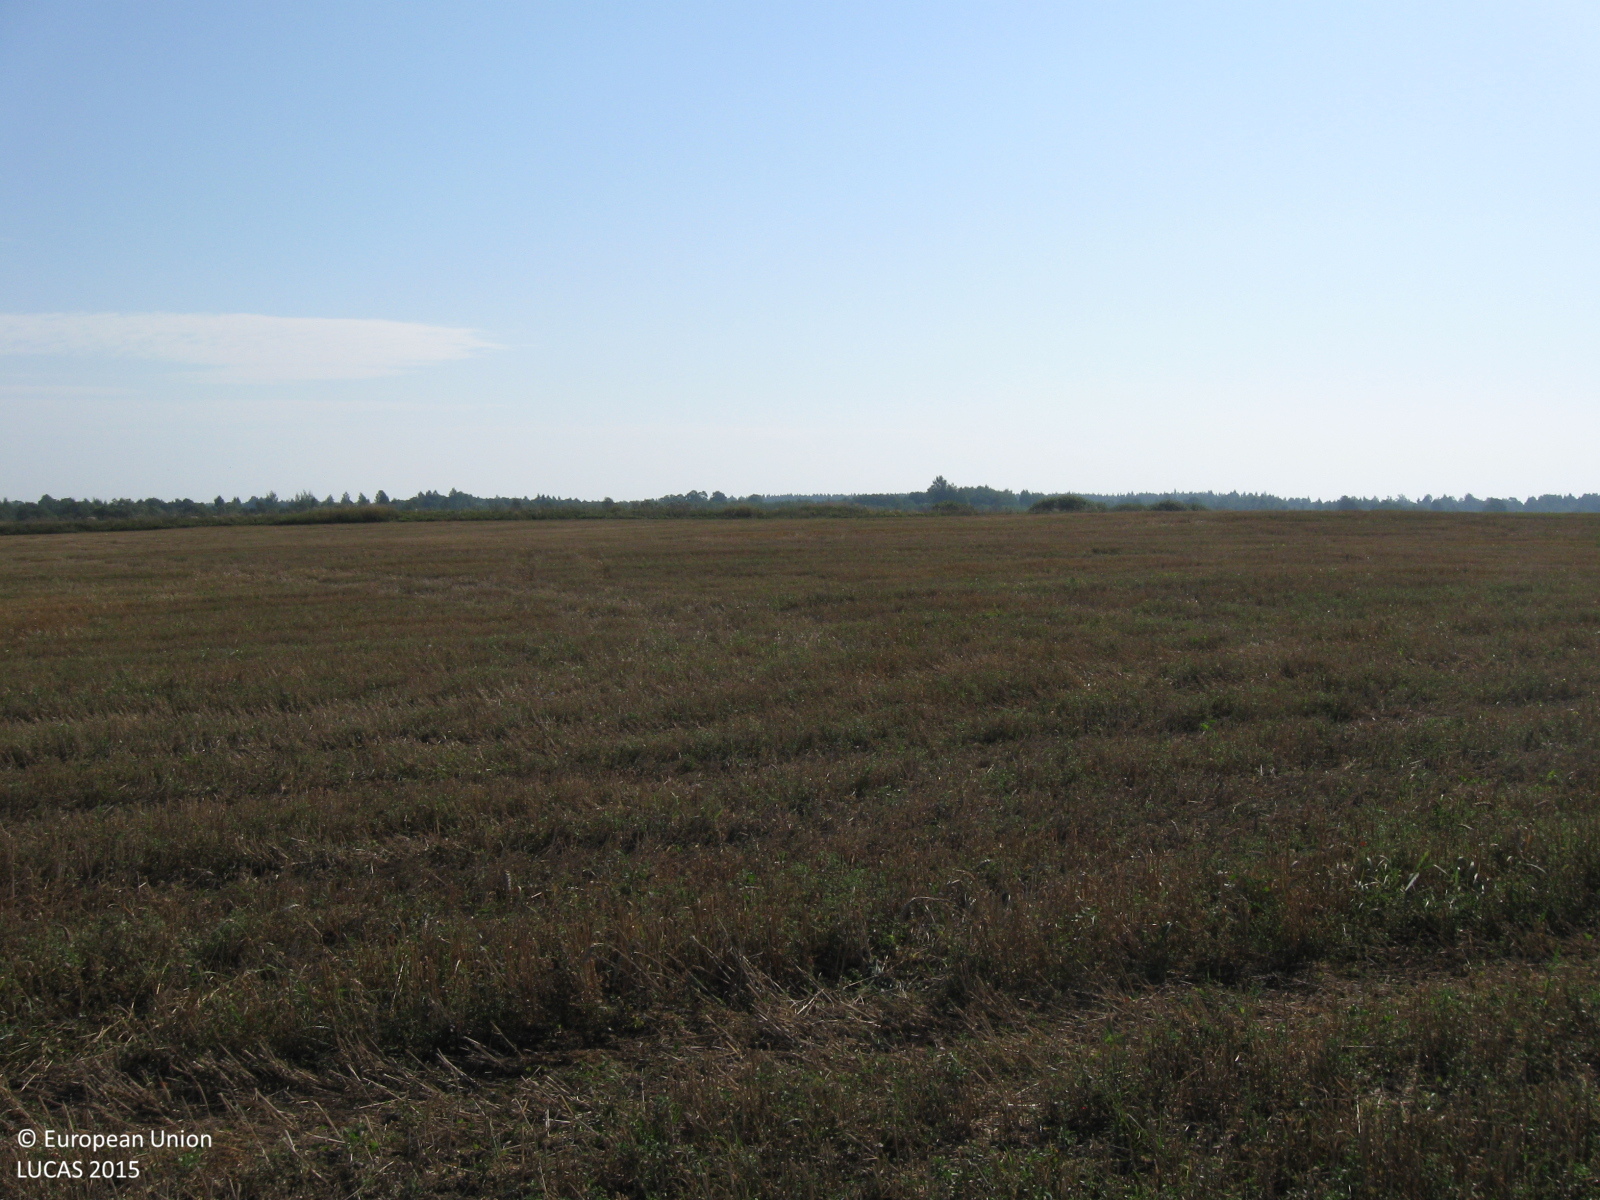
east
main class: Cropland
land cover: Common wheat
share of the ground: > 75 %
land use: Agriculture (excluding fallow land and kitchen gardens)
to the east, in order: Common wheat; Shruby margins; Tracks; Spontaneously vegetated surfaces; Common wheat
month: August
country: LT
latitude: 55.5040
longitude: 23.0047
